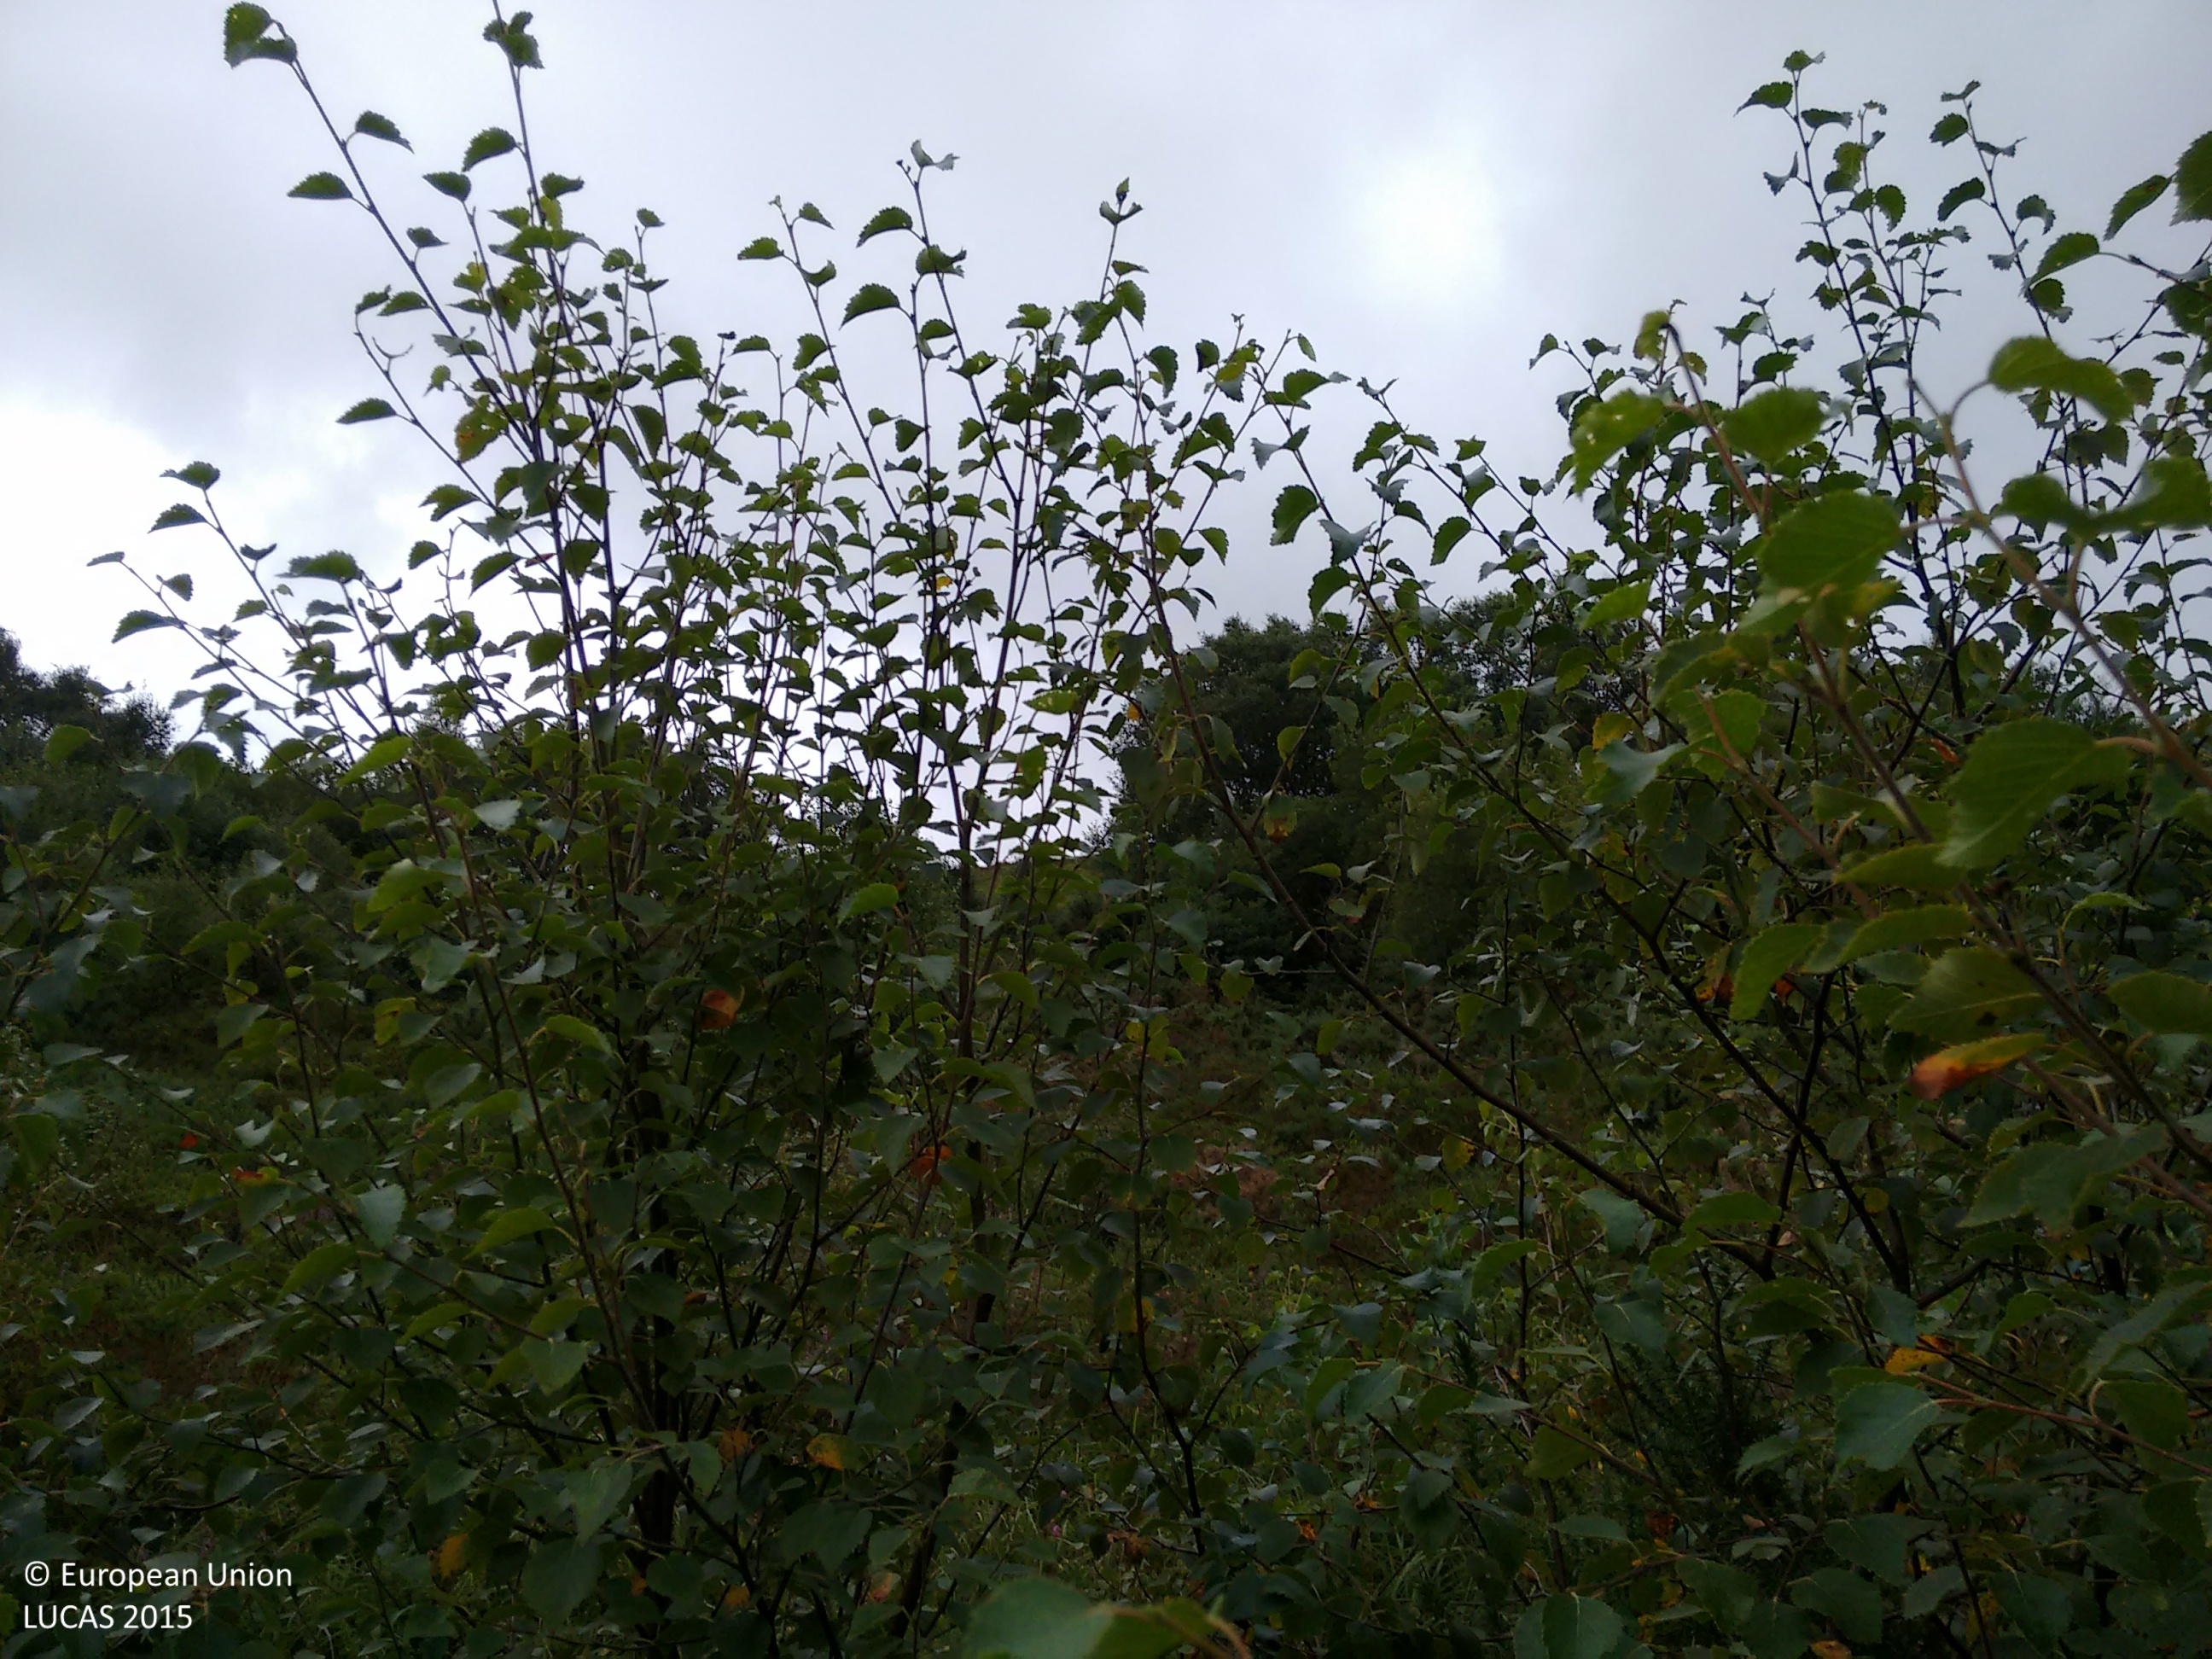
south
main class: Shrubland
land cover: Shrubland with sparse tree cover
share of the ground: > 75 %
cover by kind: shrubs 70 %, herbaceous plants 25 %, broadleaved forest trees 5 %
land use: Semi-natural and natural areas not in use
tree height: < 5 m
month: August
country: IE
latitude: 51.8927
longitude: -9.4557
